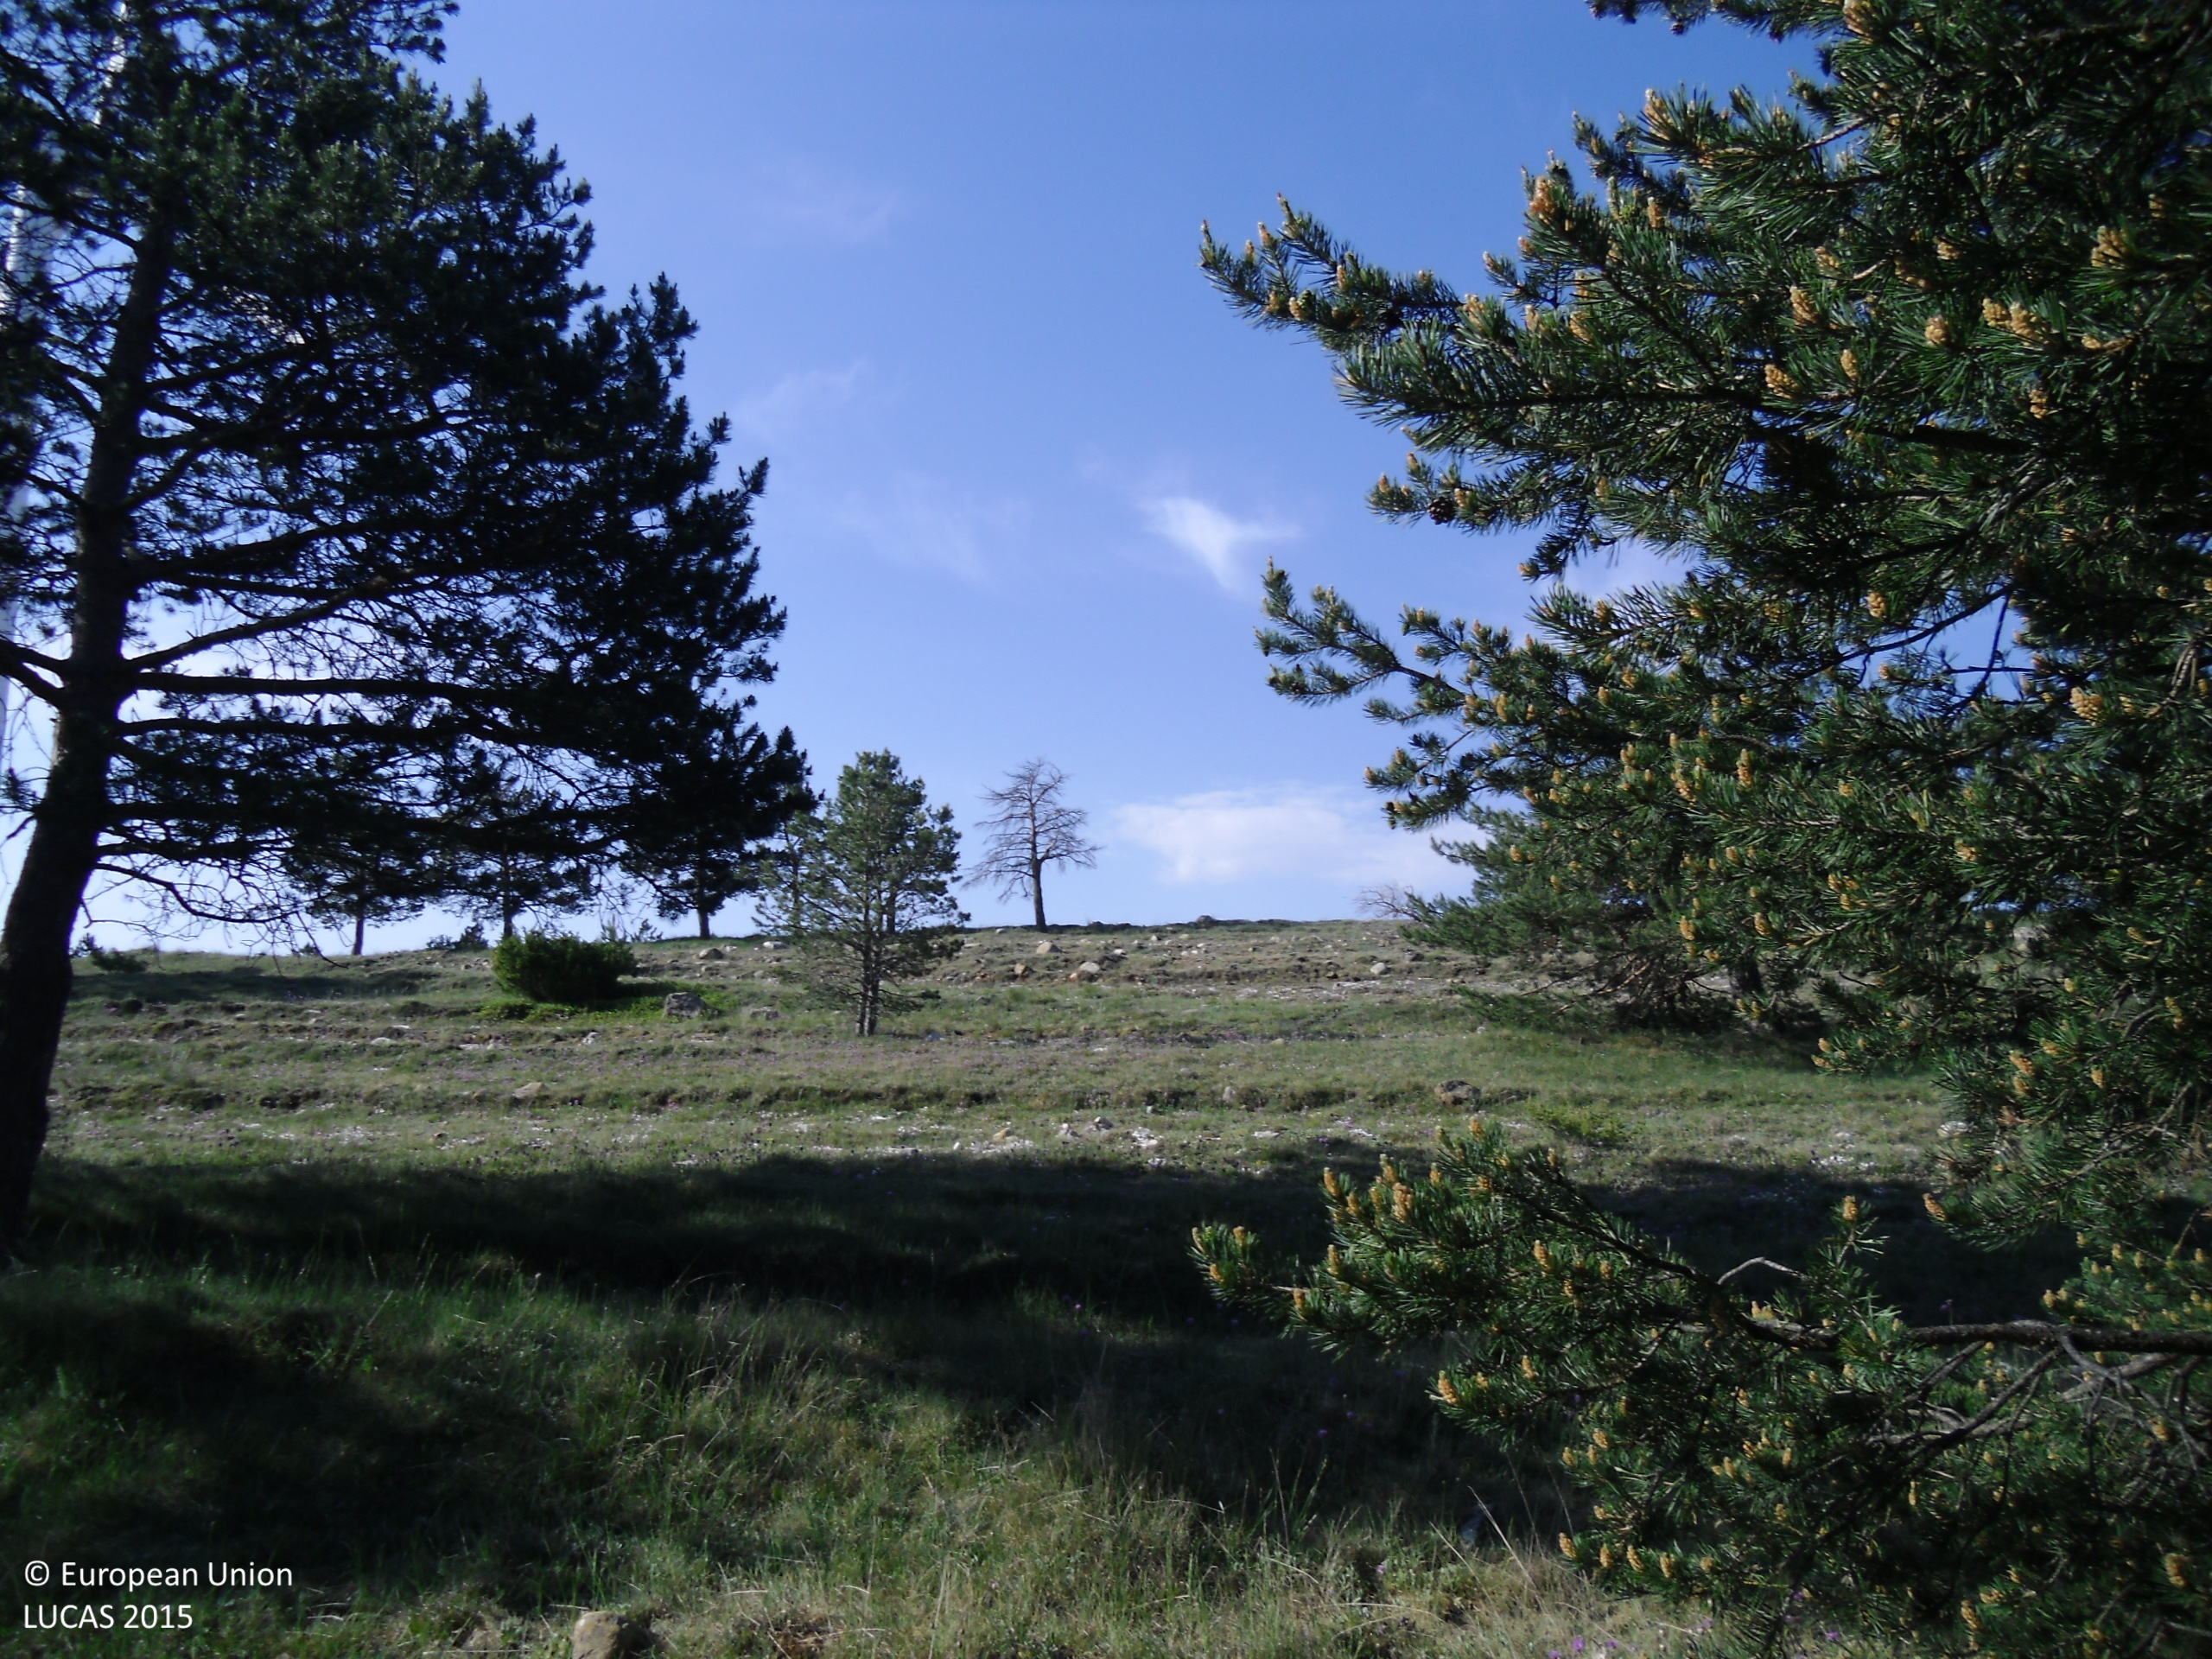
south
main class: Woodland
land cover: Pine dominated coniferous woodland
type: coniferous forest of the mediterranean region
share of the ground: 50 - 75 %
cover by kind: coniferous forest trees 60 %, herbaceous plants 40 %
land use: Forestry
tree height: > 5 m
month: May
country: ES
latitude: 40.7628
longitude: -0.8046
